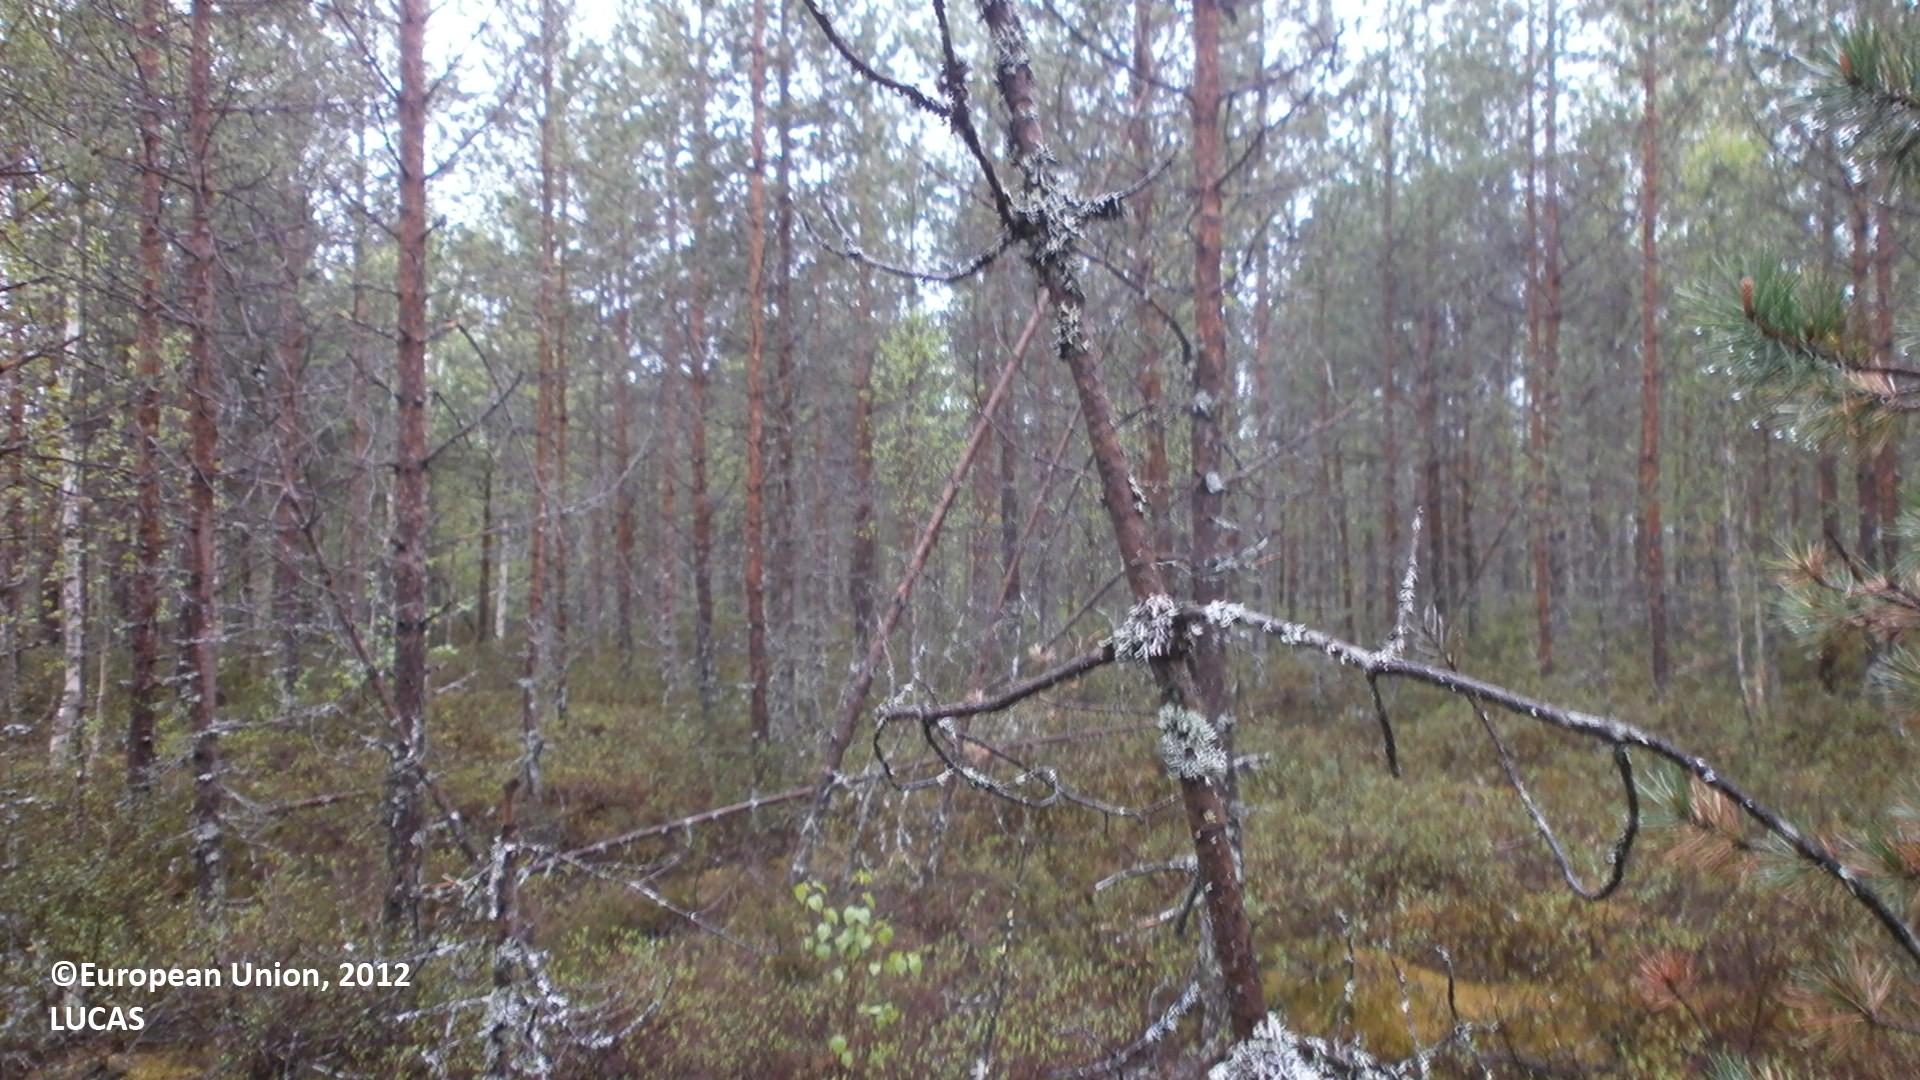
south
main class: Woodland
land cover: Pine dominated coniferous woodland
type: mire and swamp forests
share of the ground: 50 - 75 %
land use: Forestry
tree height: > 5 m
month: June
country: FI
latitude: 64.0877
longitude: 26.0863
